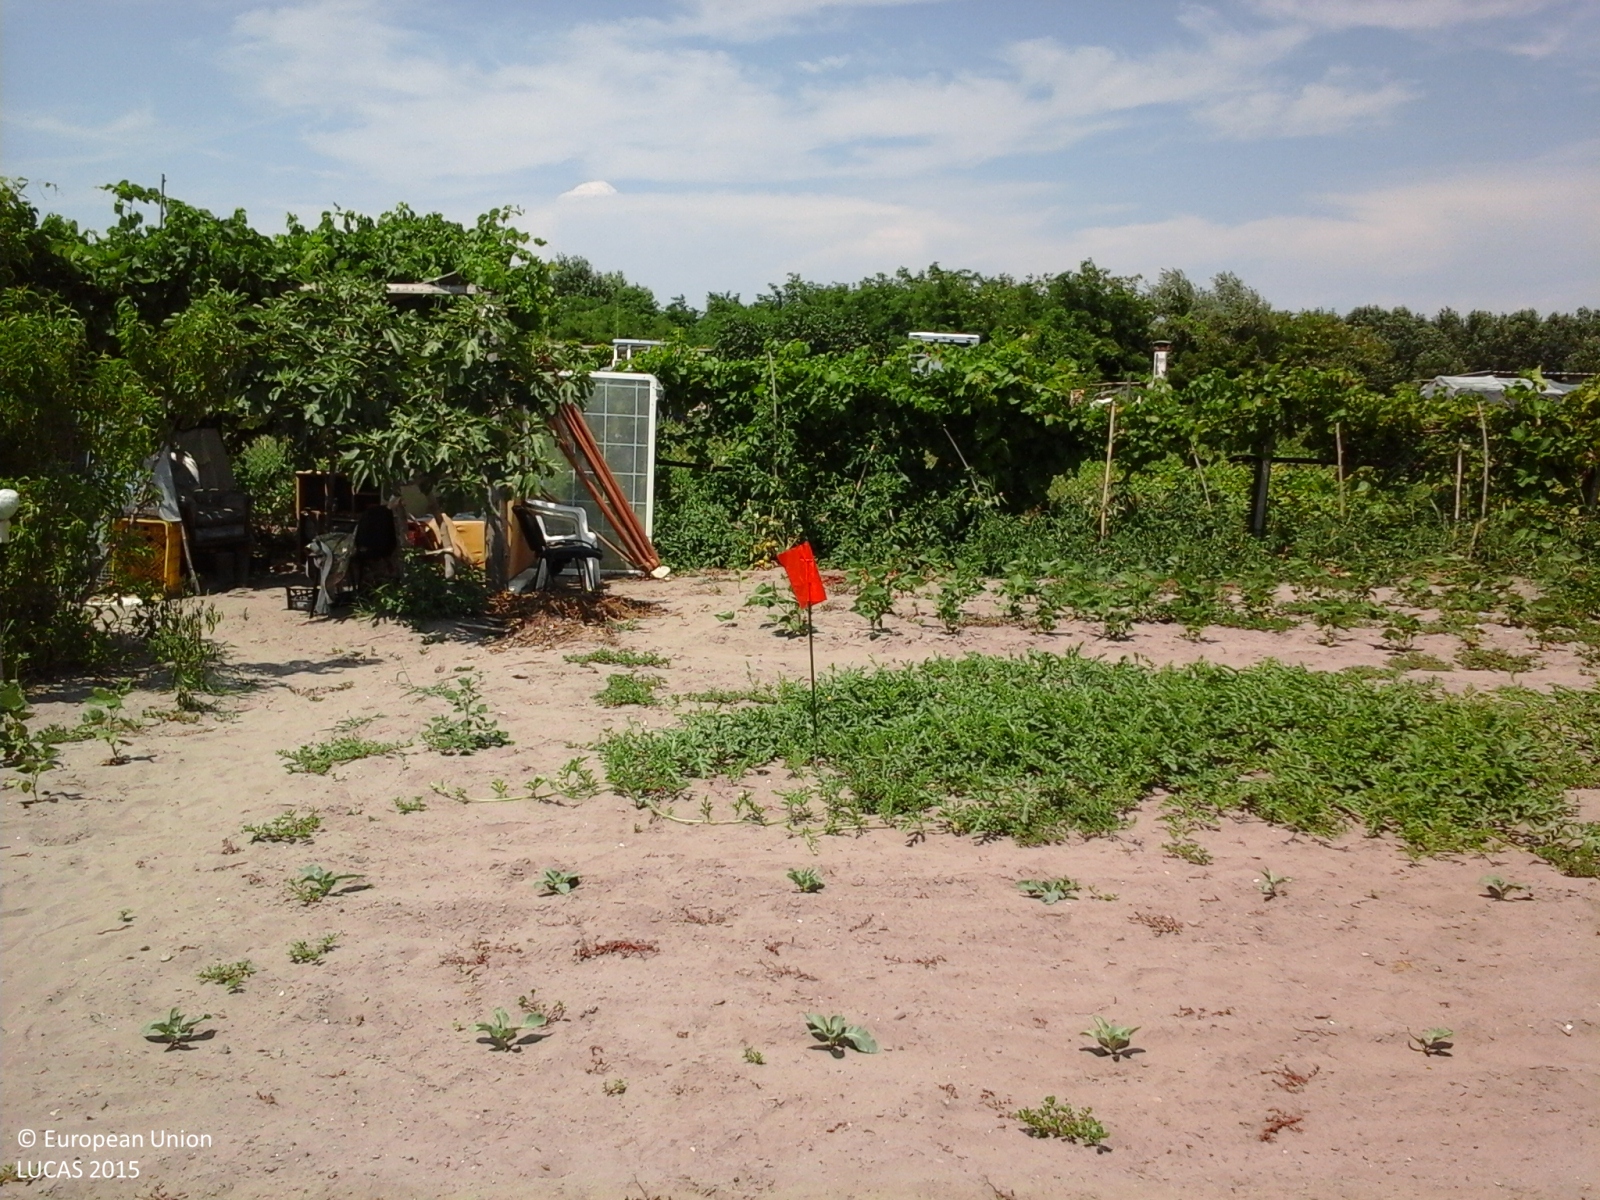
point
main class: Cropland
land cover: Other fresh vegetables
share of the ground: 10 - 25 %
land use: Agriculture (excluding fallow land and kitchen gardens)
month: July
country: IT
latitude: 45.1909
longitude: 12.2999
